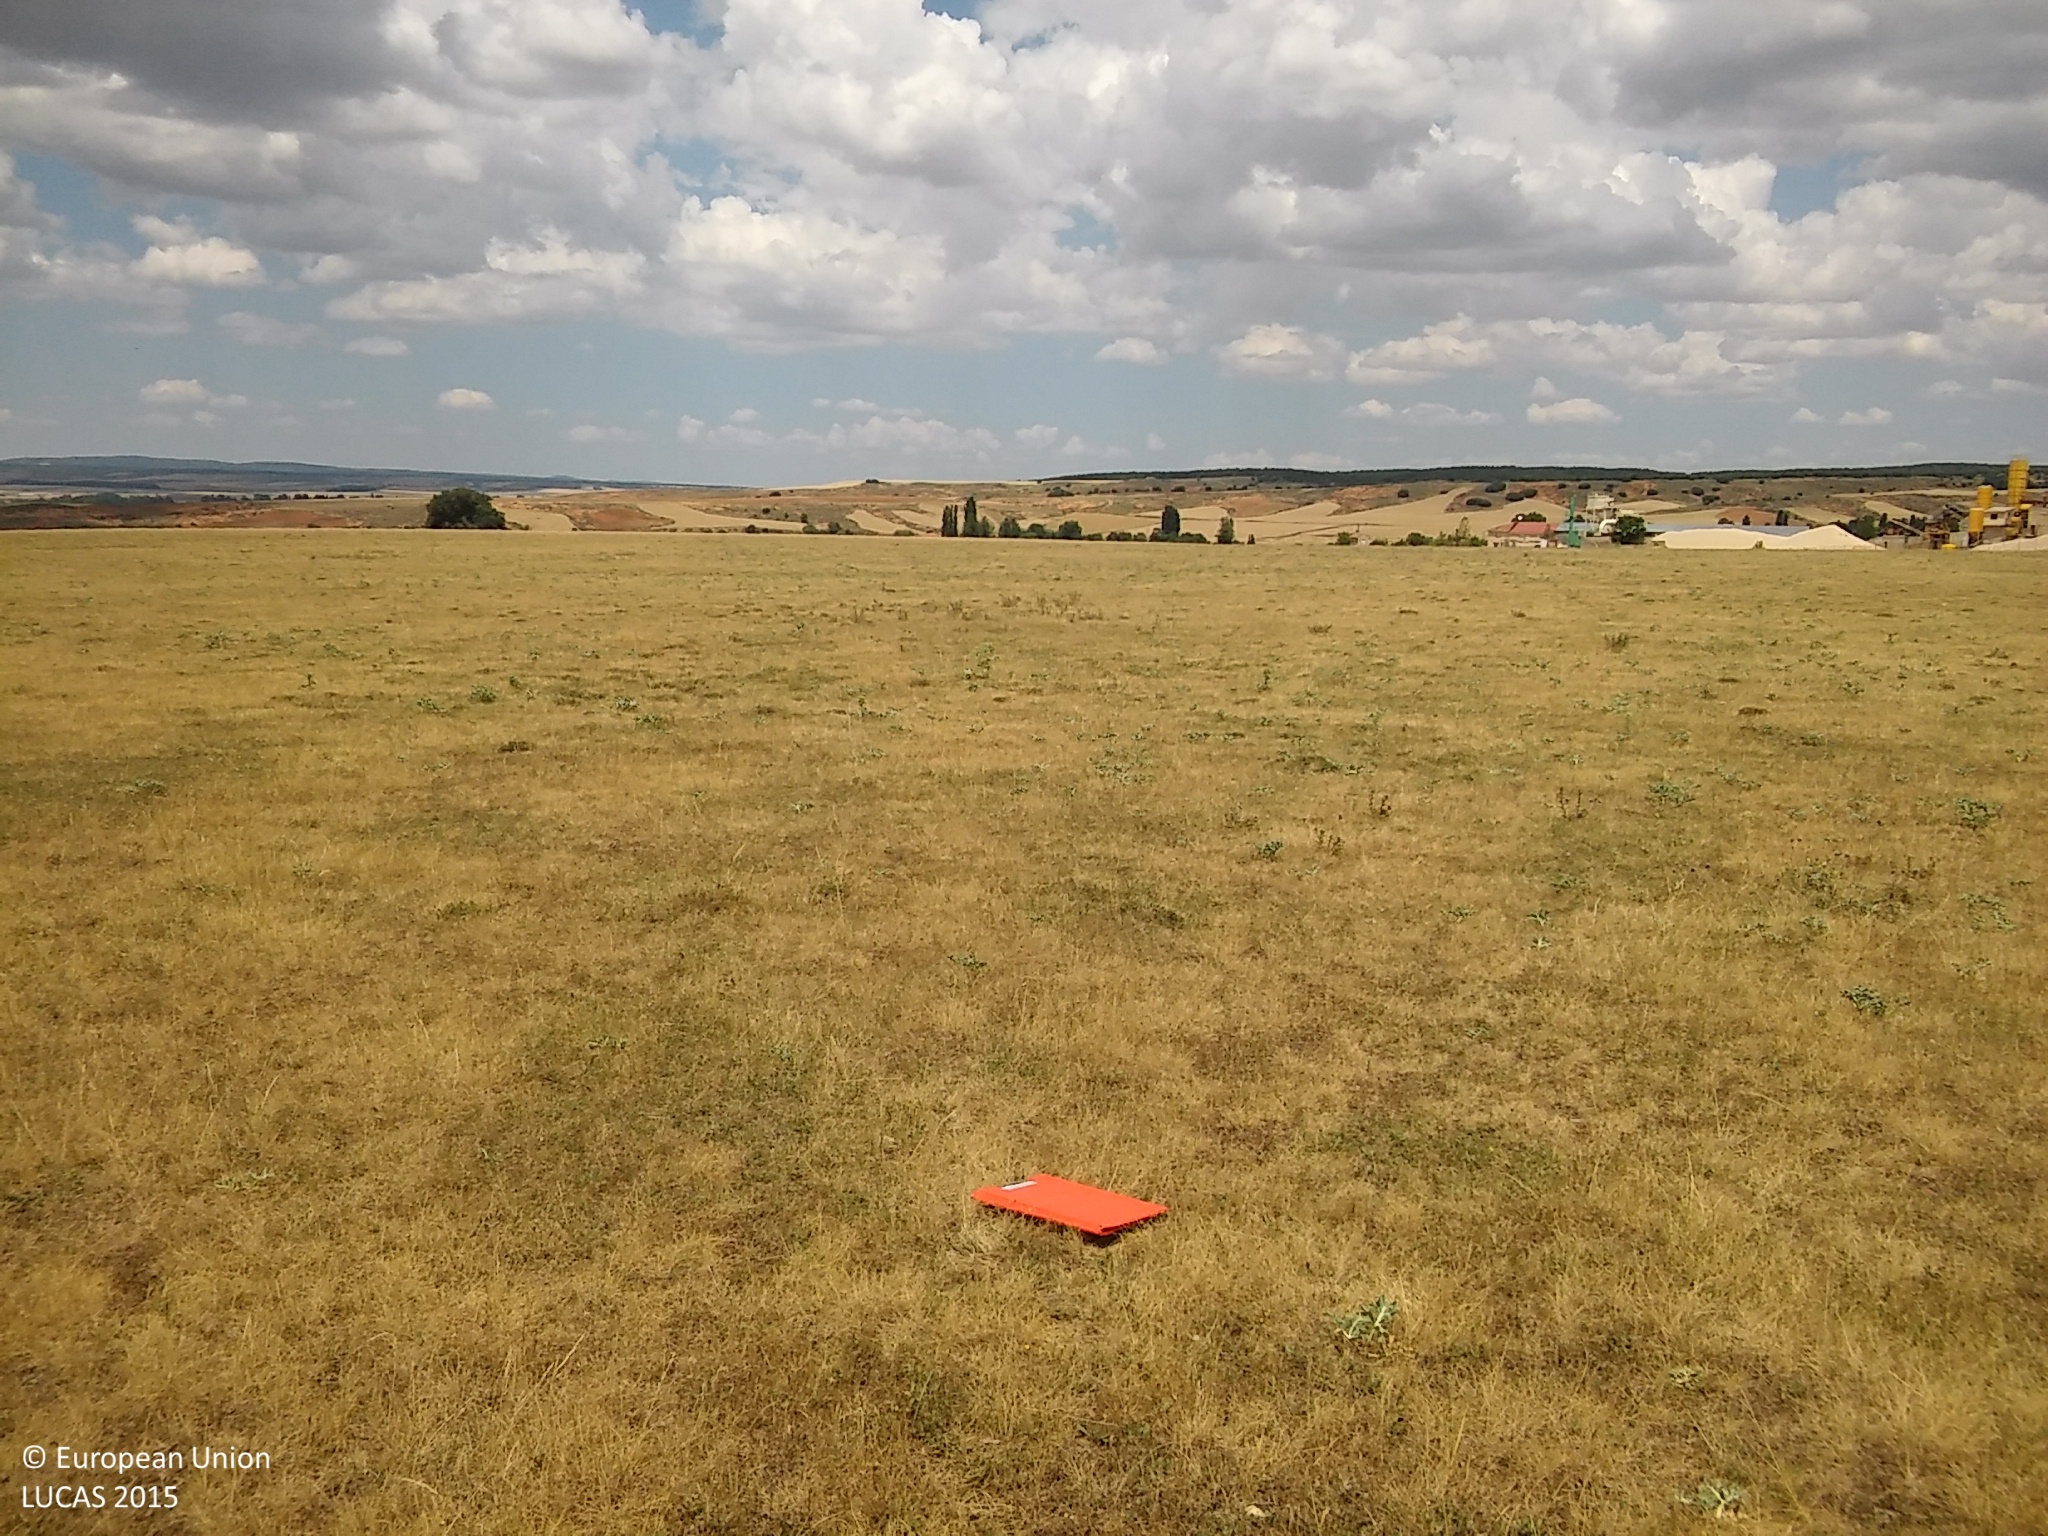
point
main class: Grassland
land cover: Grassland without tree/shrub cover
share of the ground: > 75 %
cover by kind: herbaceous plants 100 %
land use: Agriculture (excluding fallow land and kitchen gardens)
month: June
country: ES
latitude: 41.2863
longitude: -3.6476
